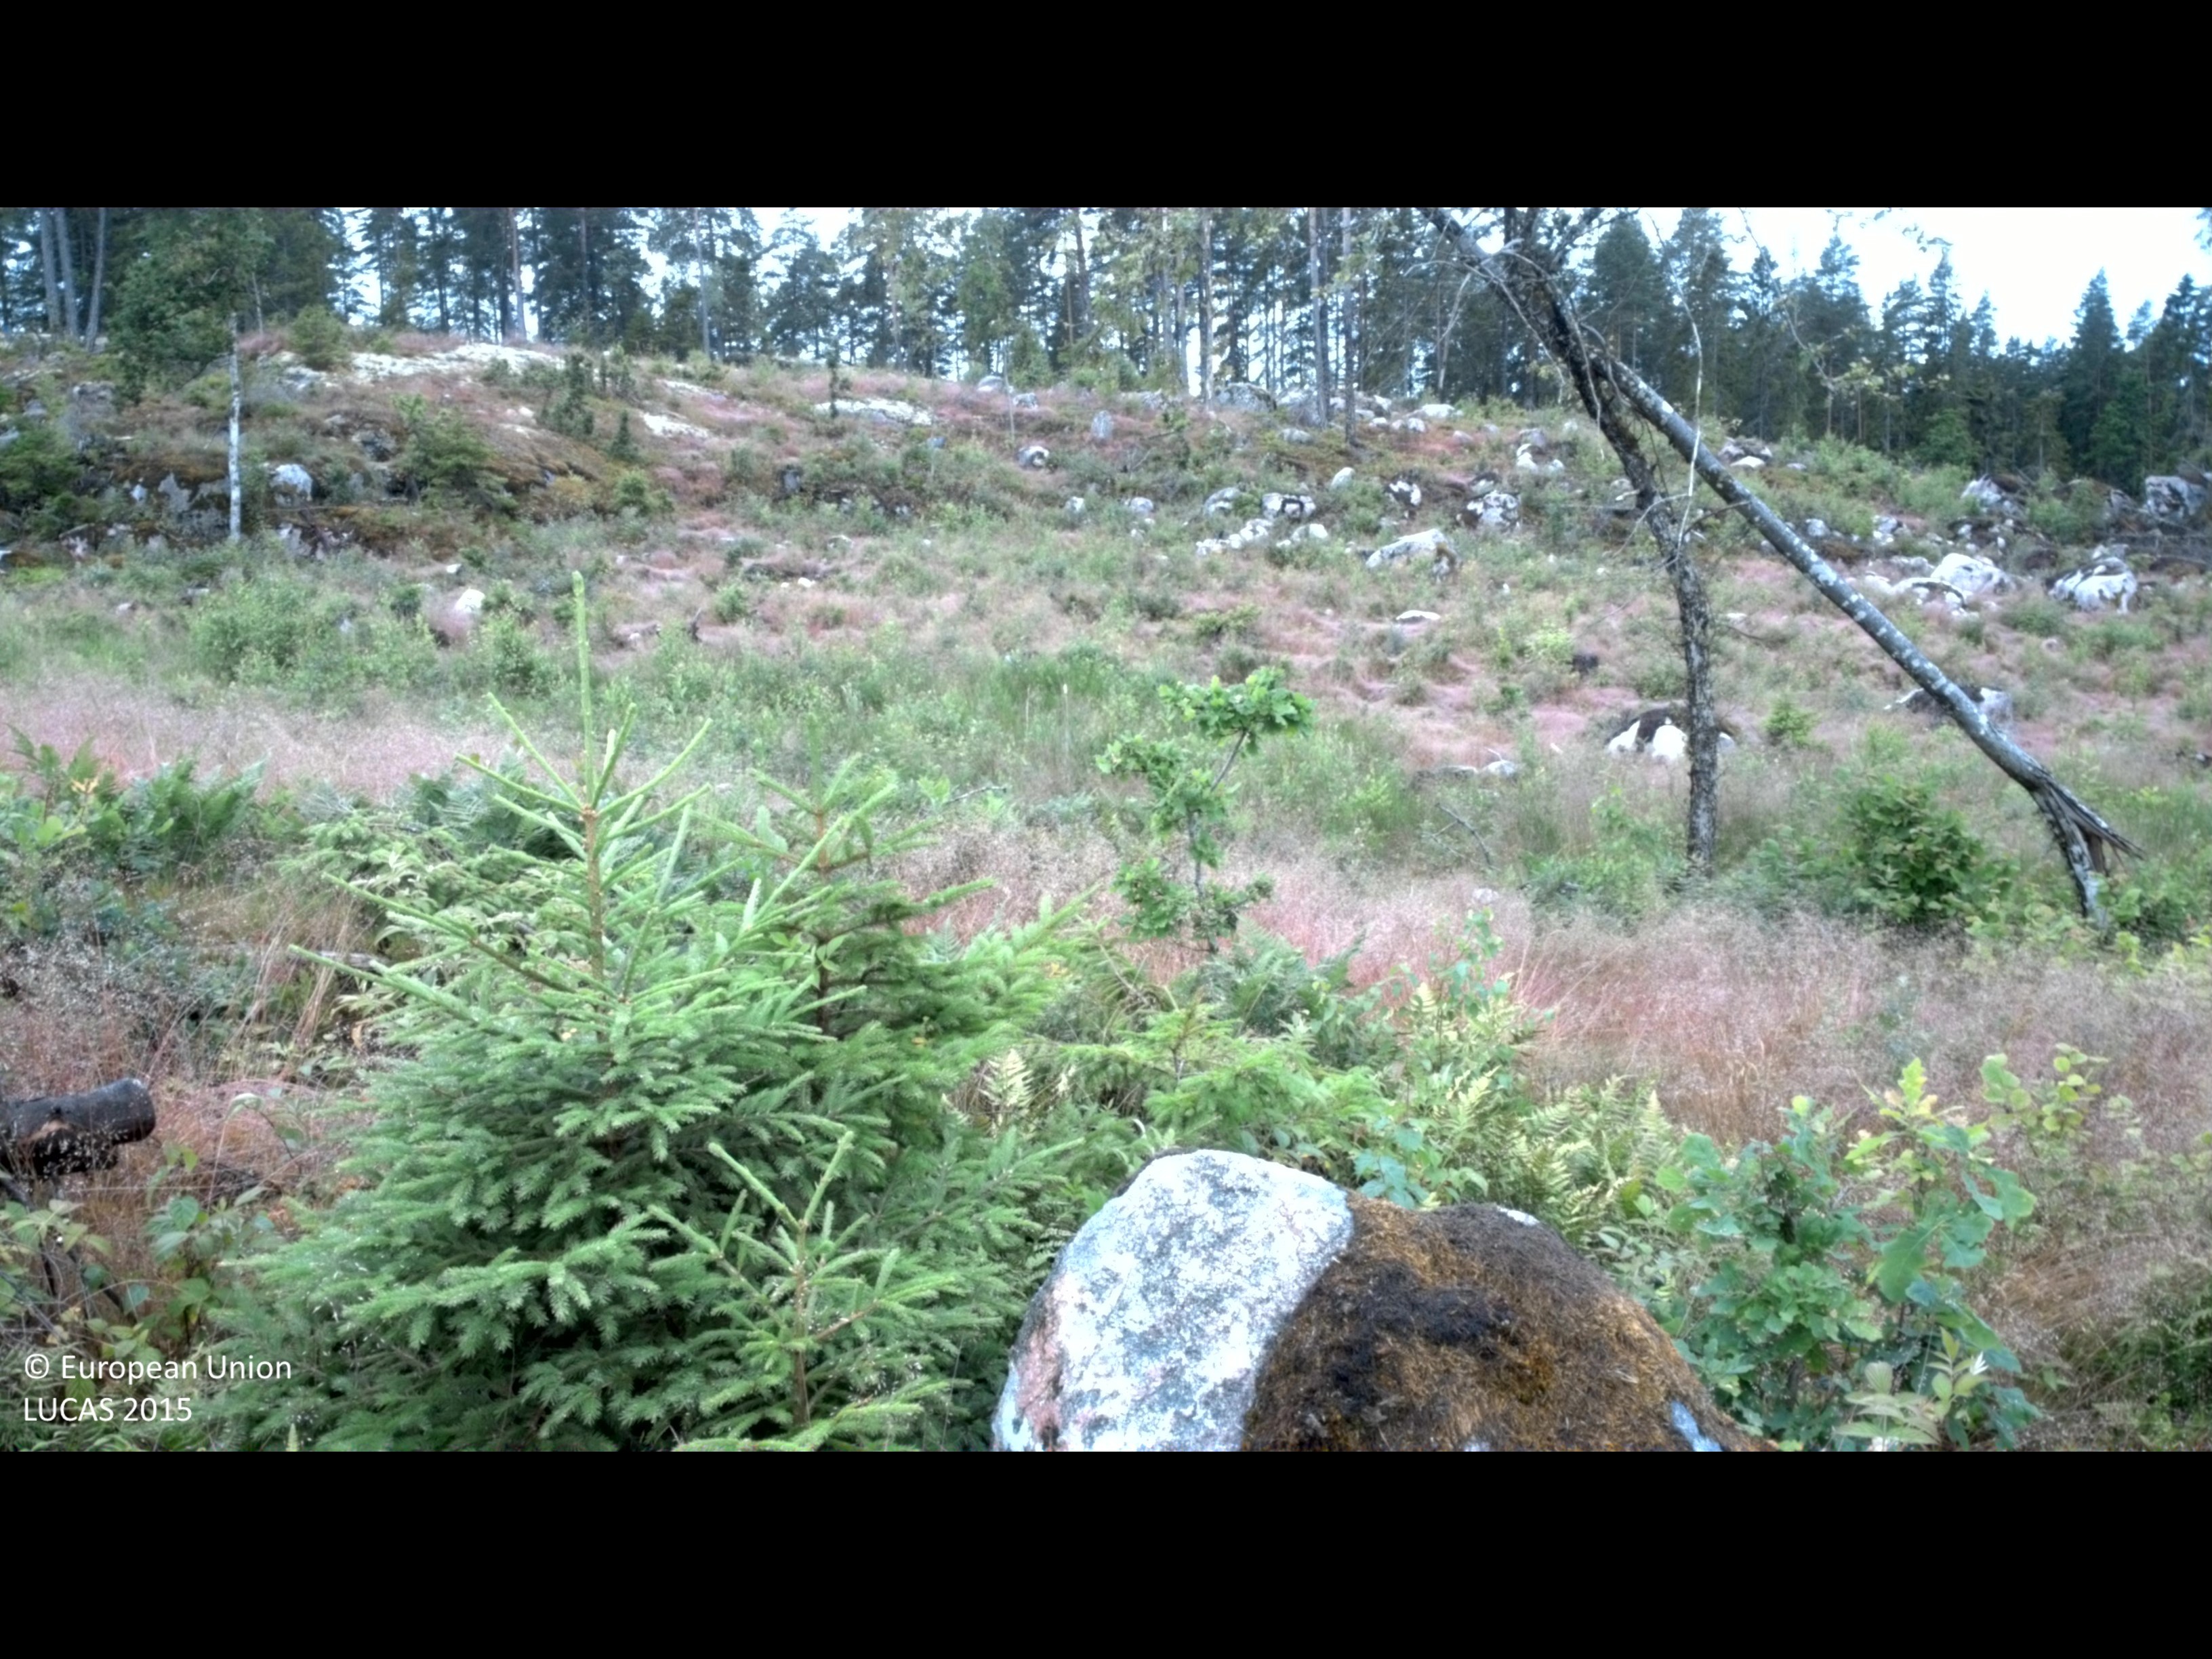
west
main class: Woodland
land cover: Other mixed woodland
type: boreal forest
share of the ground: 10 - 25 %
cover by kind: shrubs 45 %, herbaceous plants 40 %, broadleaved forest trees 10 %, coniferous forest trees 5 %
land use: Forestry
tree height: < 5 m
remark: Clear cut
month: July
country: SE
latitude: 58.3146
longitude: 16.1237
